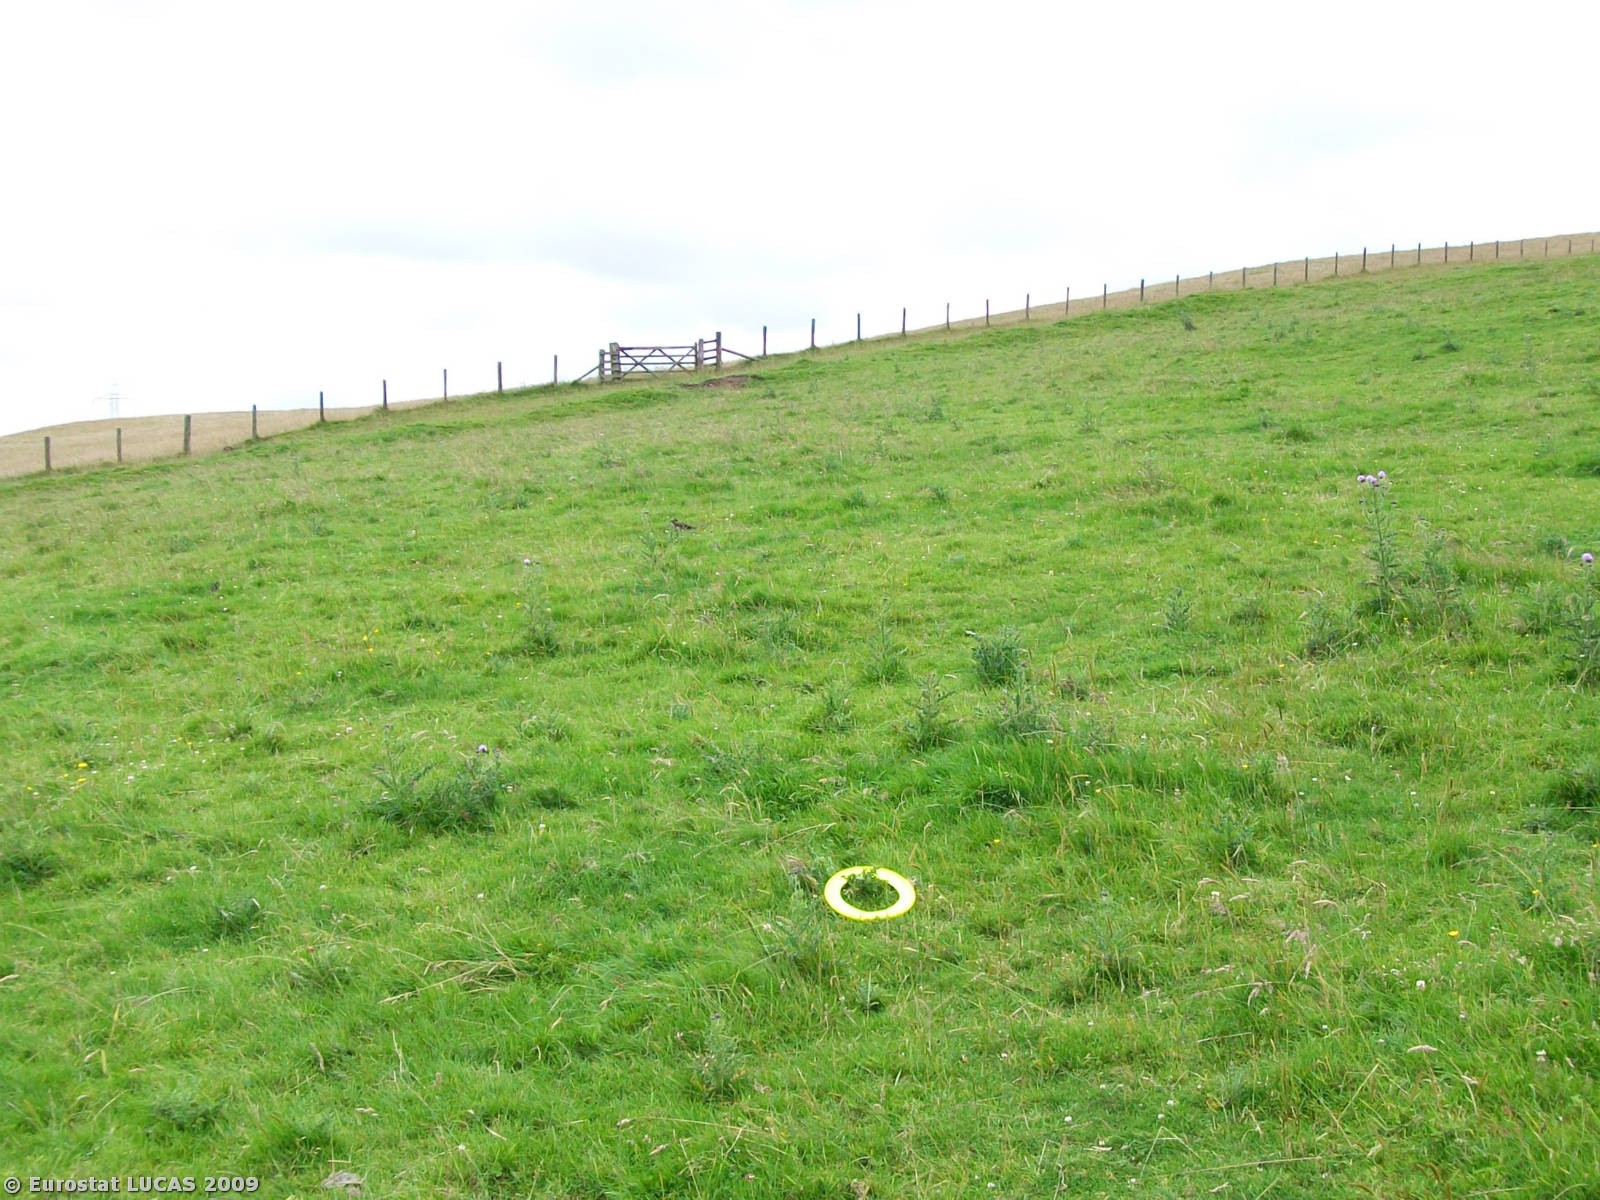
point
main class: Grassland
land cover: Grassland without tree/shrub cover
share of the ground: > 75 %
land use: Agriculture (excluding fallow land and kitchen gardens)
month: July
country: GB
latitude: 55.1619
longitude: -3.3085
